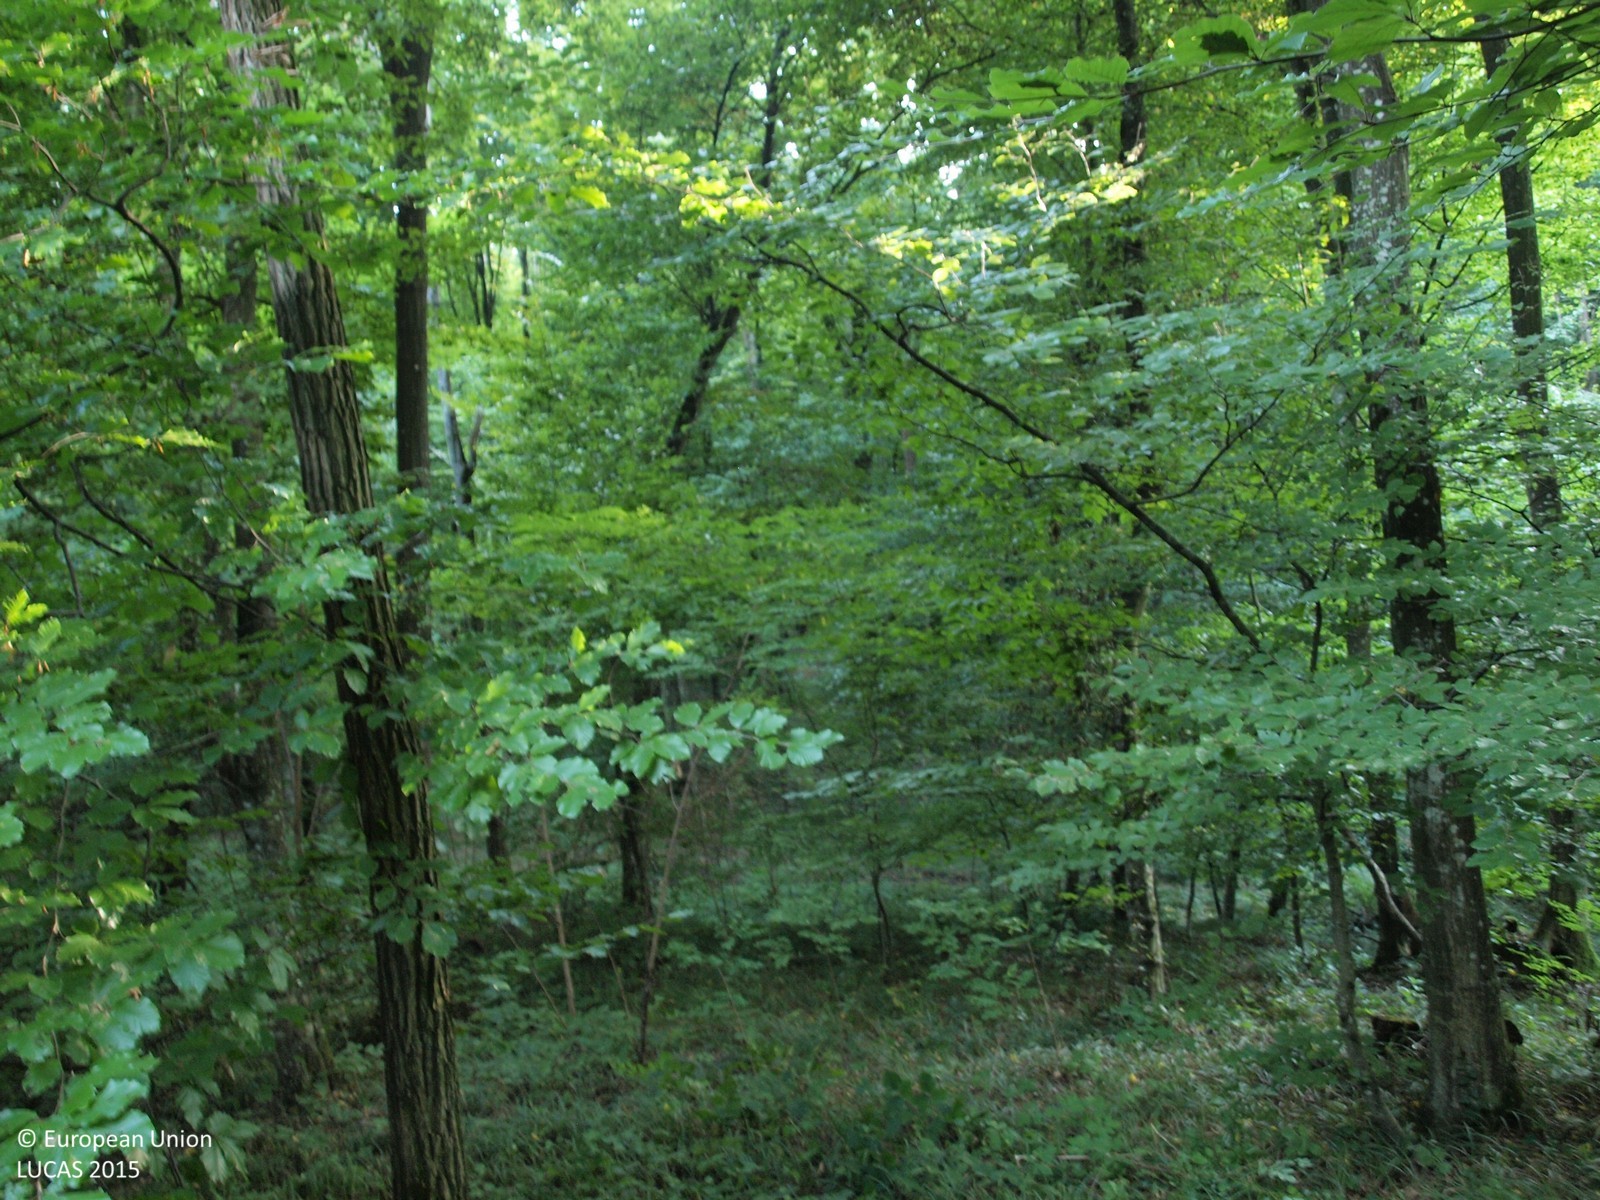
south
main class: Woodland
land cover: Broadleaved woodland
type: beech forest
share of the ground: > 75 %
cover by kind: broadleaved forest trees 100 %
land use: Forestry
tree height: > 5 m
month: August
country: HR
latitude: 46.0582
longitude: 16.5795
